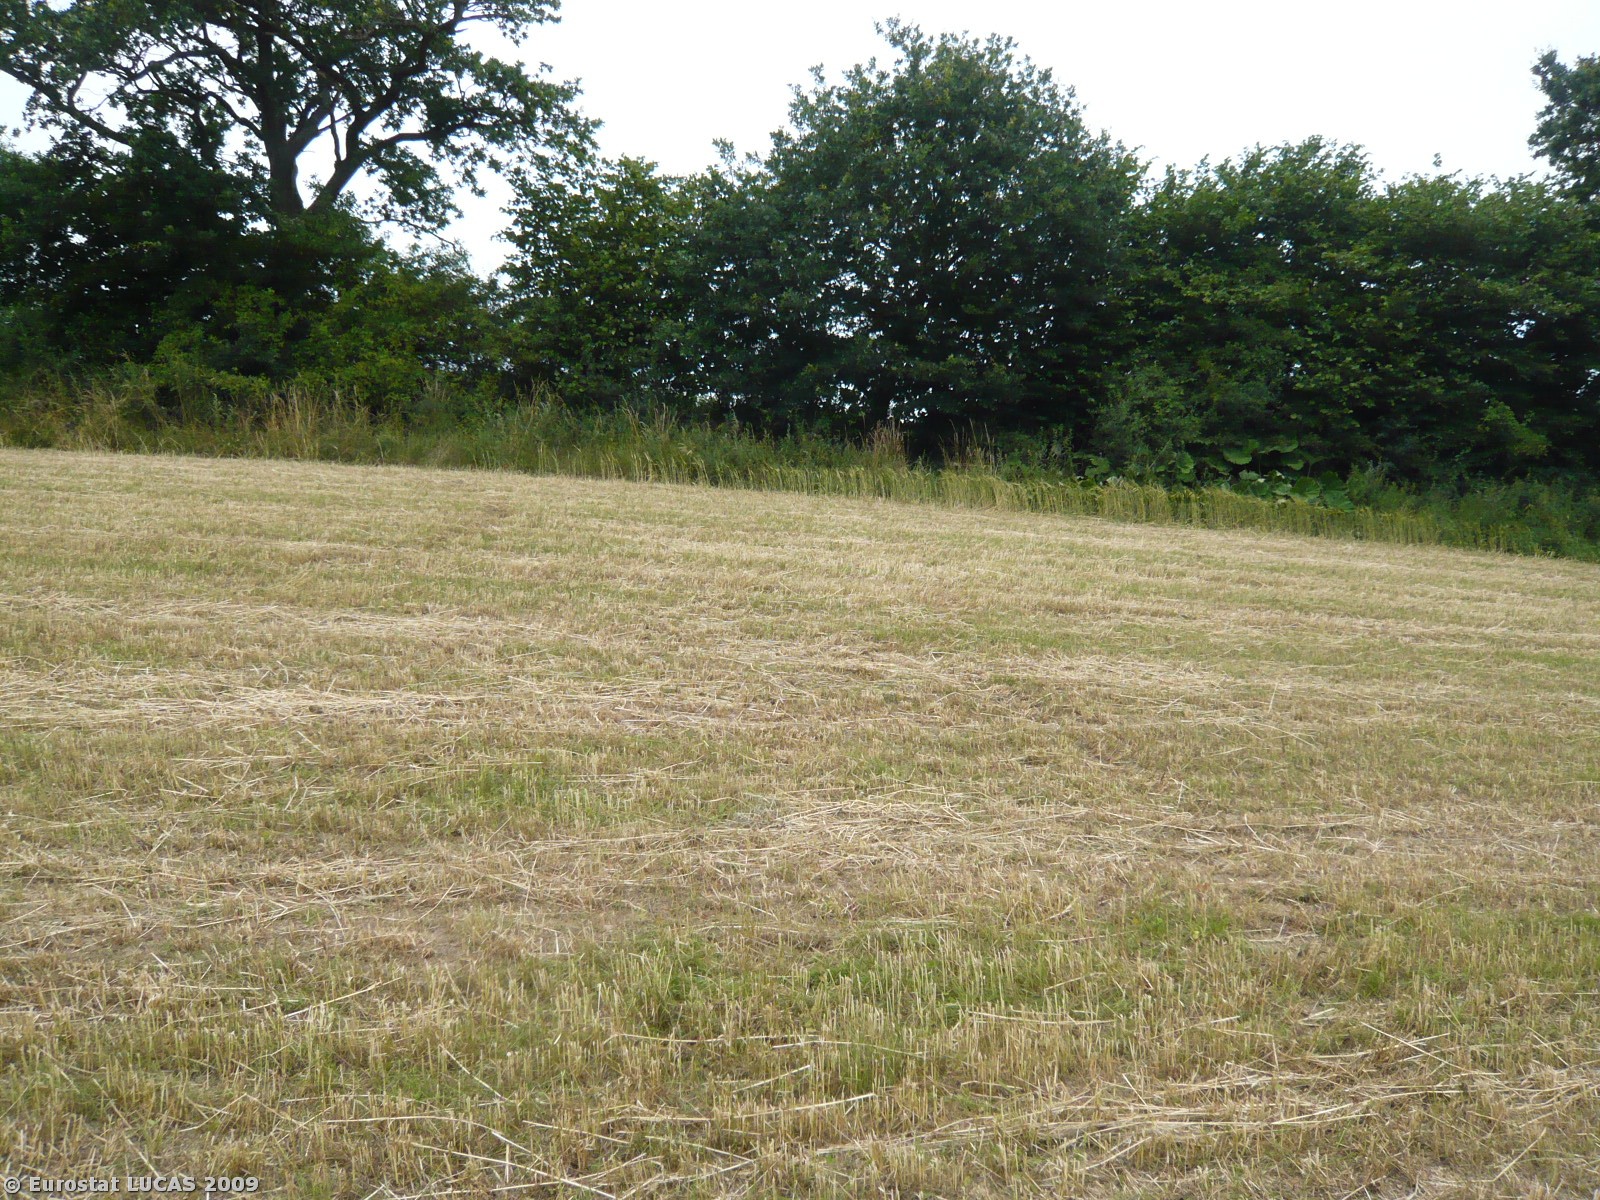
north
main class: Grassland
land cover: Grassland without tree/shrub cover
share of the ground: > 75 %
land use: Agriculture (excluding fallow land and kitchen gardens)
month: July
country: DK
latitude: 55.5285
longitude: 11.7570
